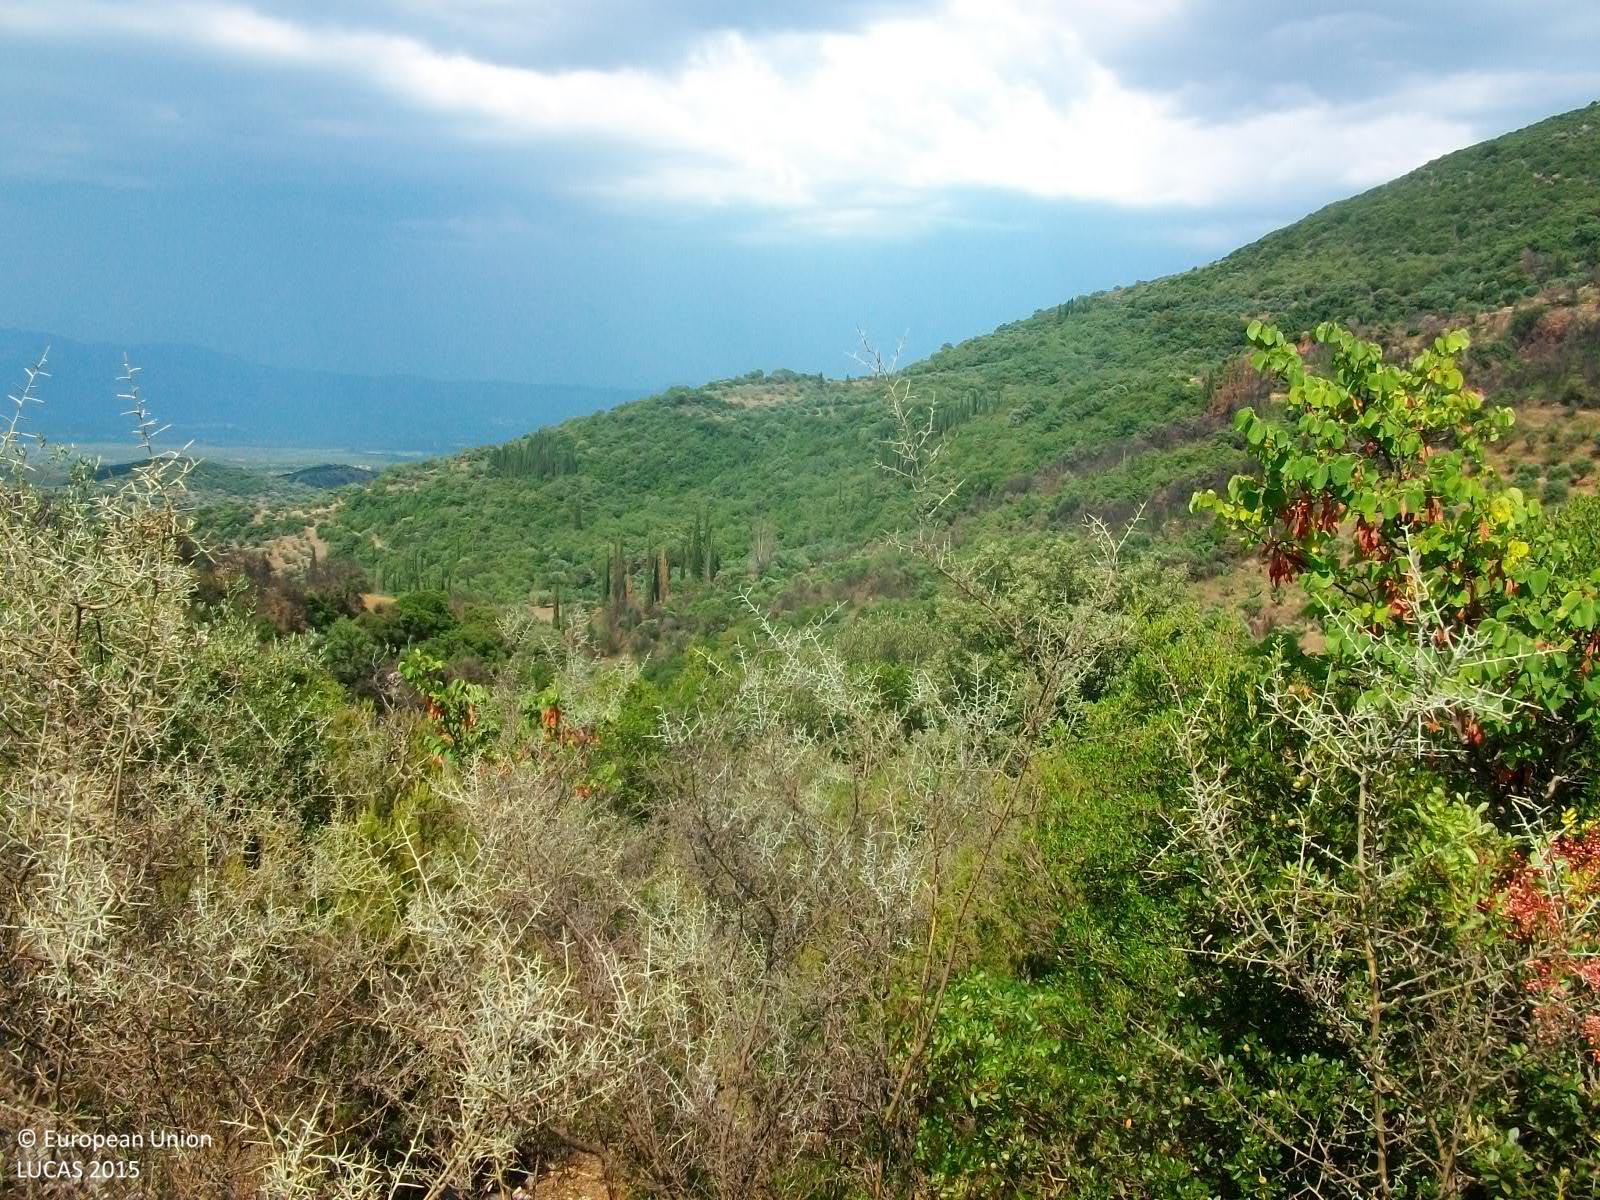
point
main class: Shrubland
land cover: Shrubland with sparse tree cover
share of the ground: > 75 %
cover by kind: shrubs 95 %, broadleaved forest trees 5 %
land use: Semi-natural and natural areas not in use
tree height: > 5 m
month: August
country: GR
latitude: 37.1979
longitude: 21.9082
